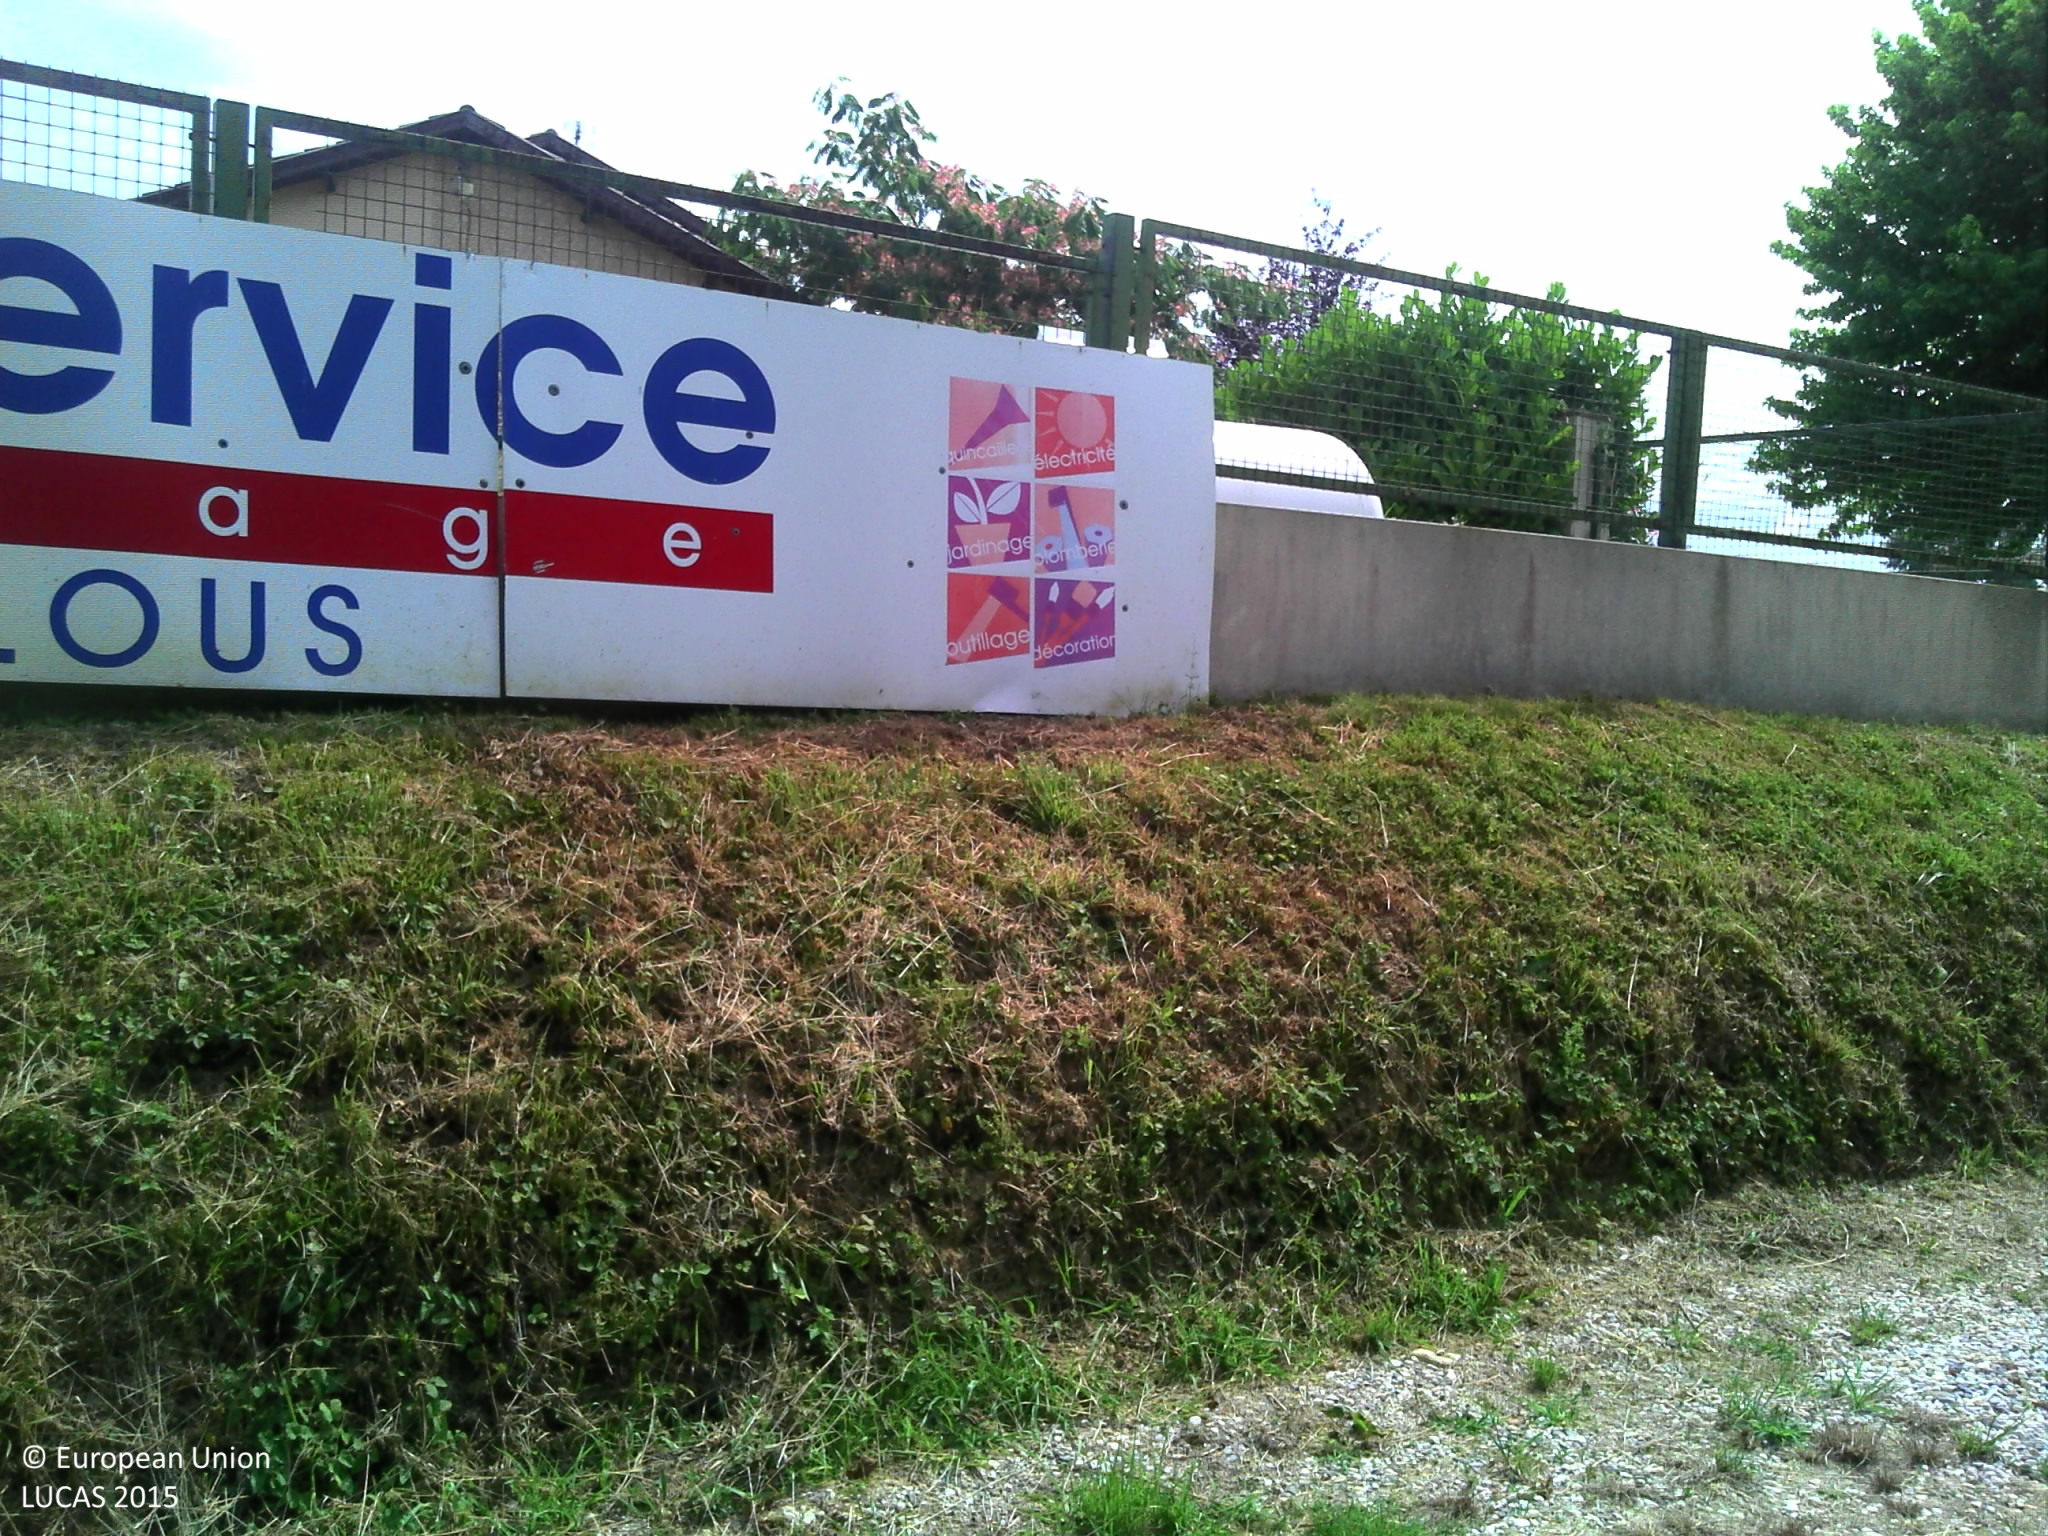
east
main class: Shrubland
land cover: Shrubland with sparse tree cover
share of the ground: > 75 %
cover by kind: shrubs 90 %, broadleaved forest trees 5 %, herbaceous plants 5 %
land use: Semi-natural and natural areas not in use
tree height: > 5 m
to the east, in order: Shrubland with sparse tree cover; Ditches and canals; Grass margins; Paved roads, cycling and walking lanes; Grass margins; Electric lines; Fences; Grassland without tree/shrub cover; Artificial constructions in urban areas; Shruby margins; Sunflower; Shruby margins; Electric lines; Paved roads, cycling and walking lanes; Shruby margins; Spontaneously vegetated surfaces
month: July
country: FR
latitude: 43.6082
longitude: -0.7540
